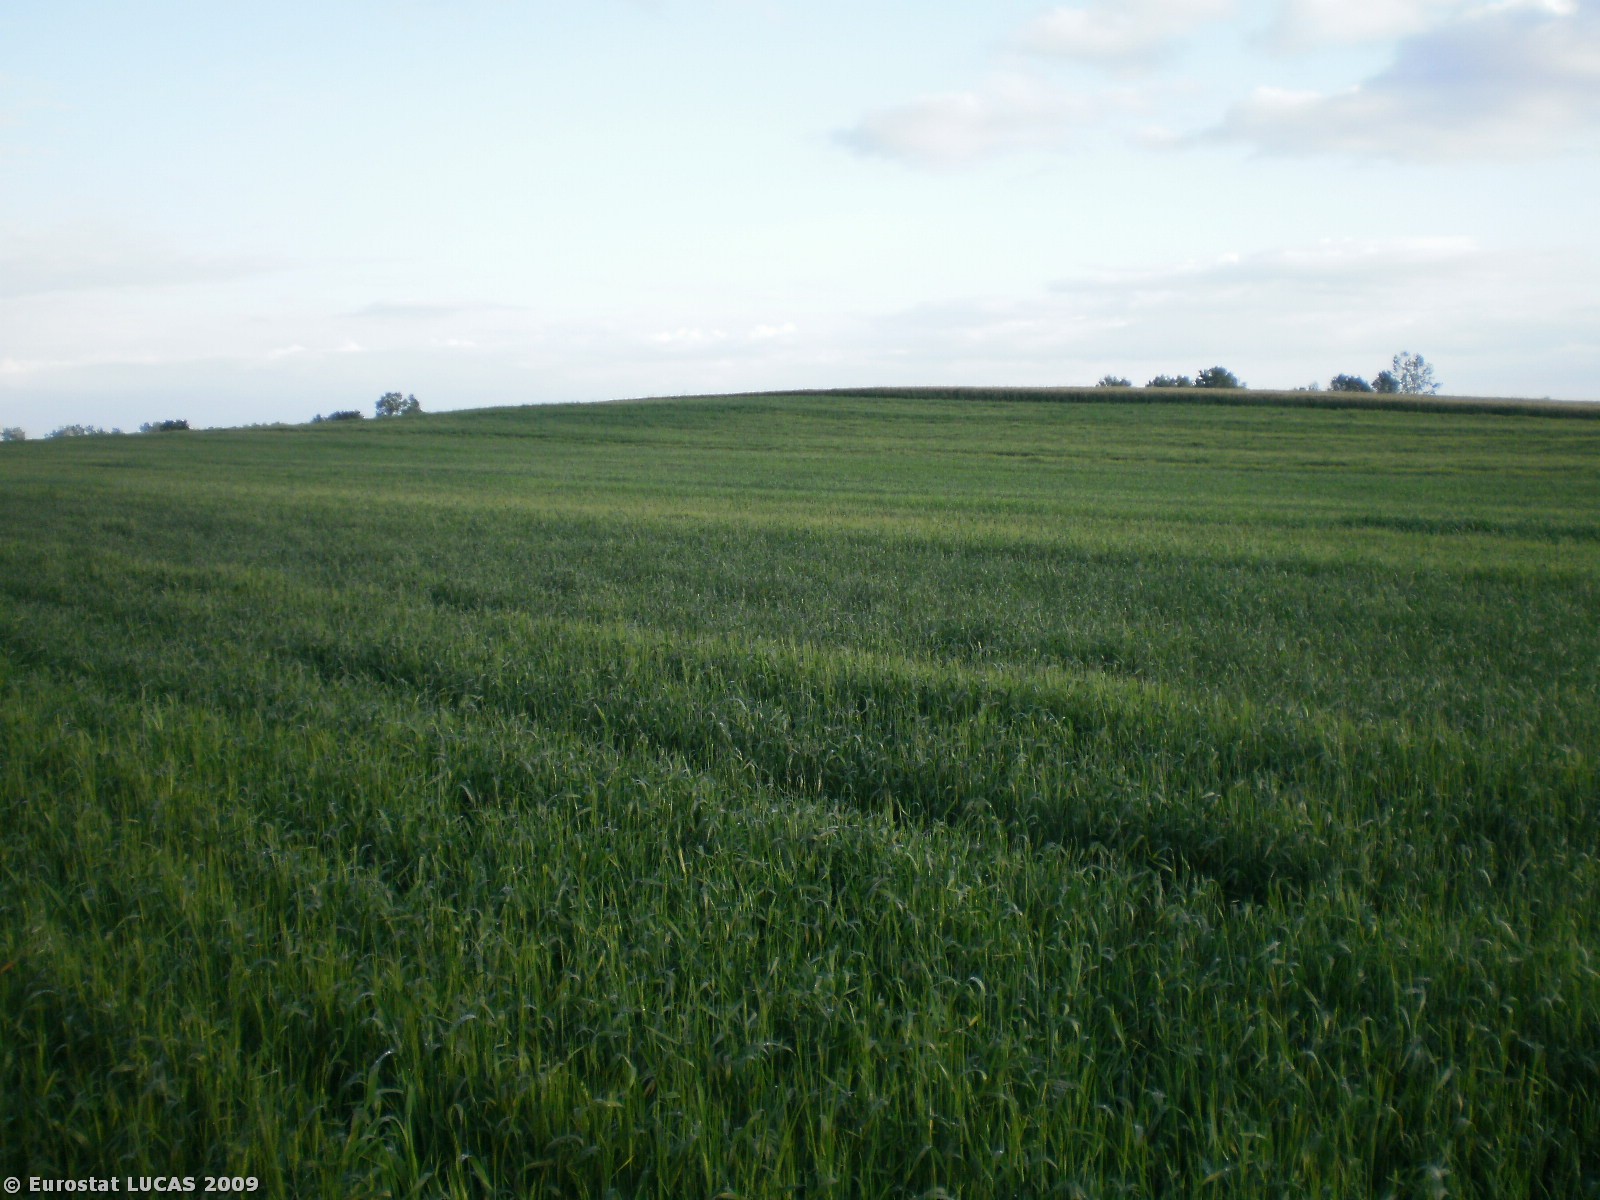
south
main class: Cropland
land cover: Triticale
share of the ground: > 75 %
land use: Agriculture (excluding fallow land and kitchen gardens)
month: June
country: PL
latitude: 53.4917
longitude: 19.8118
